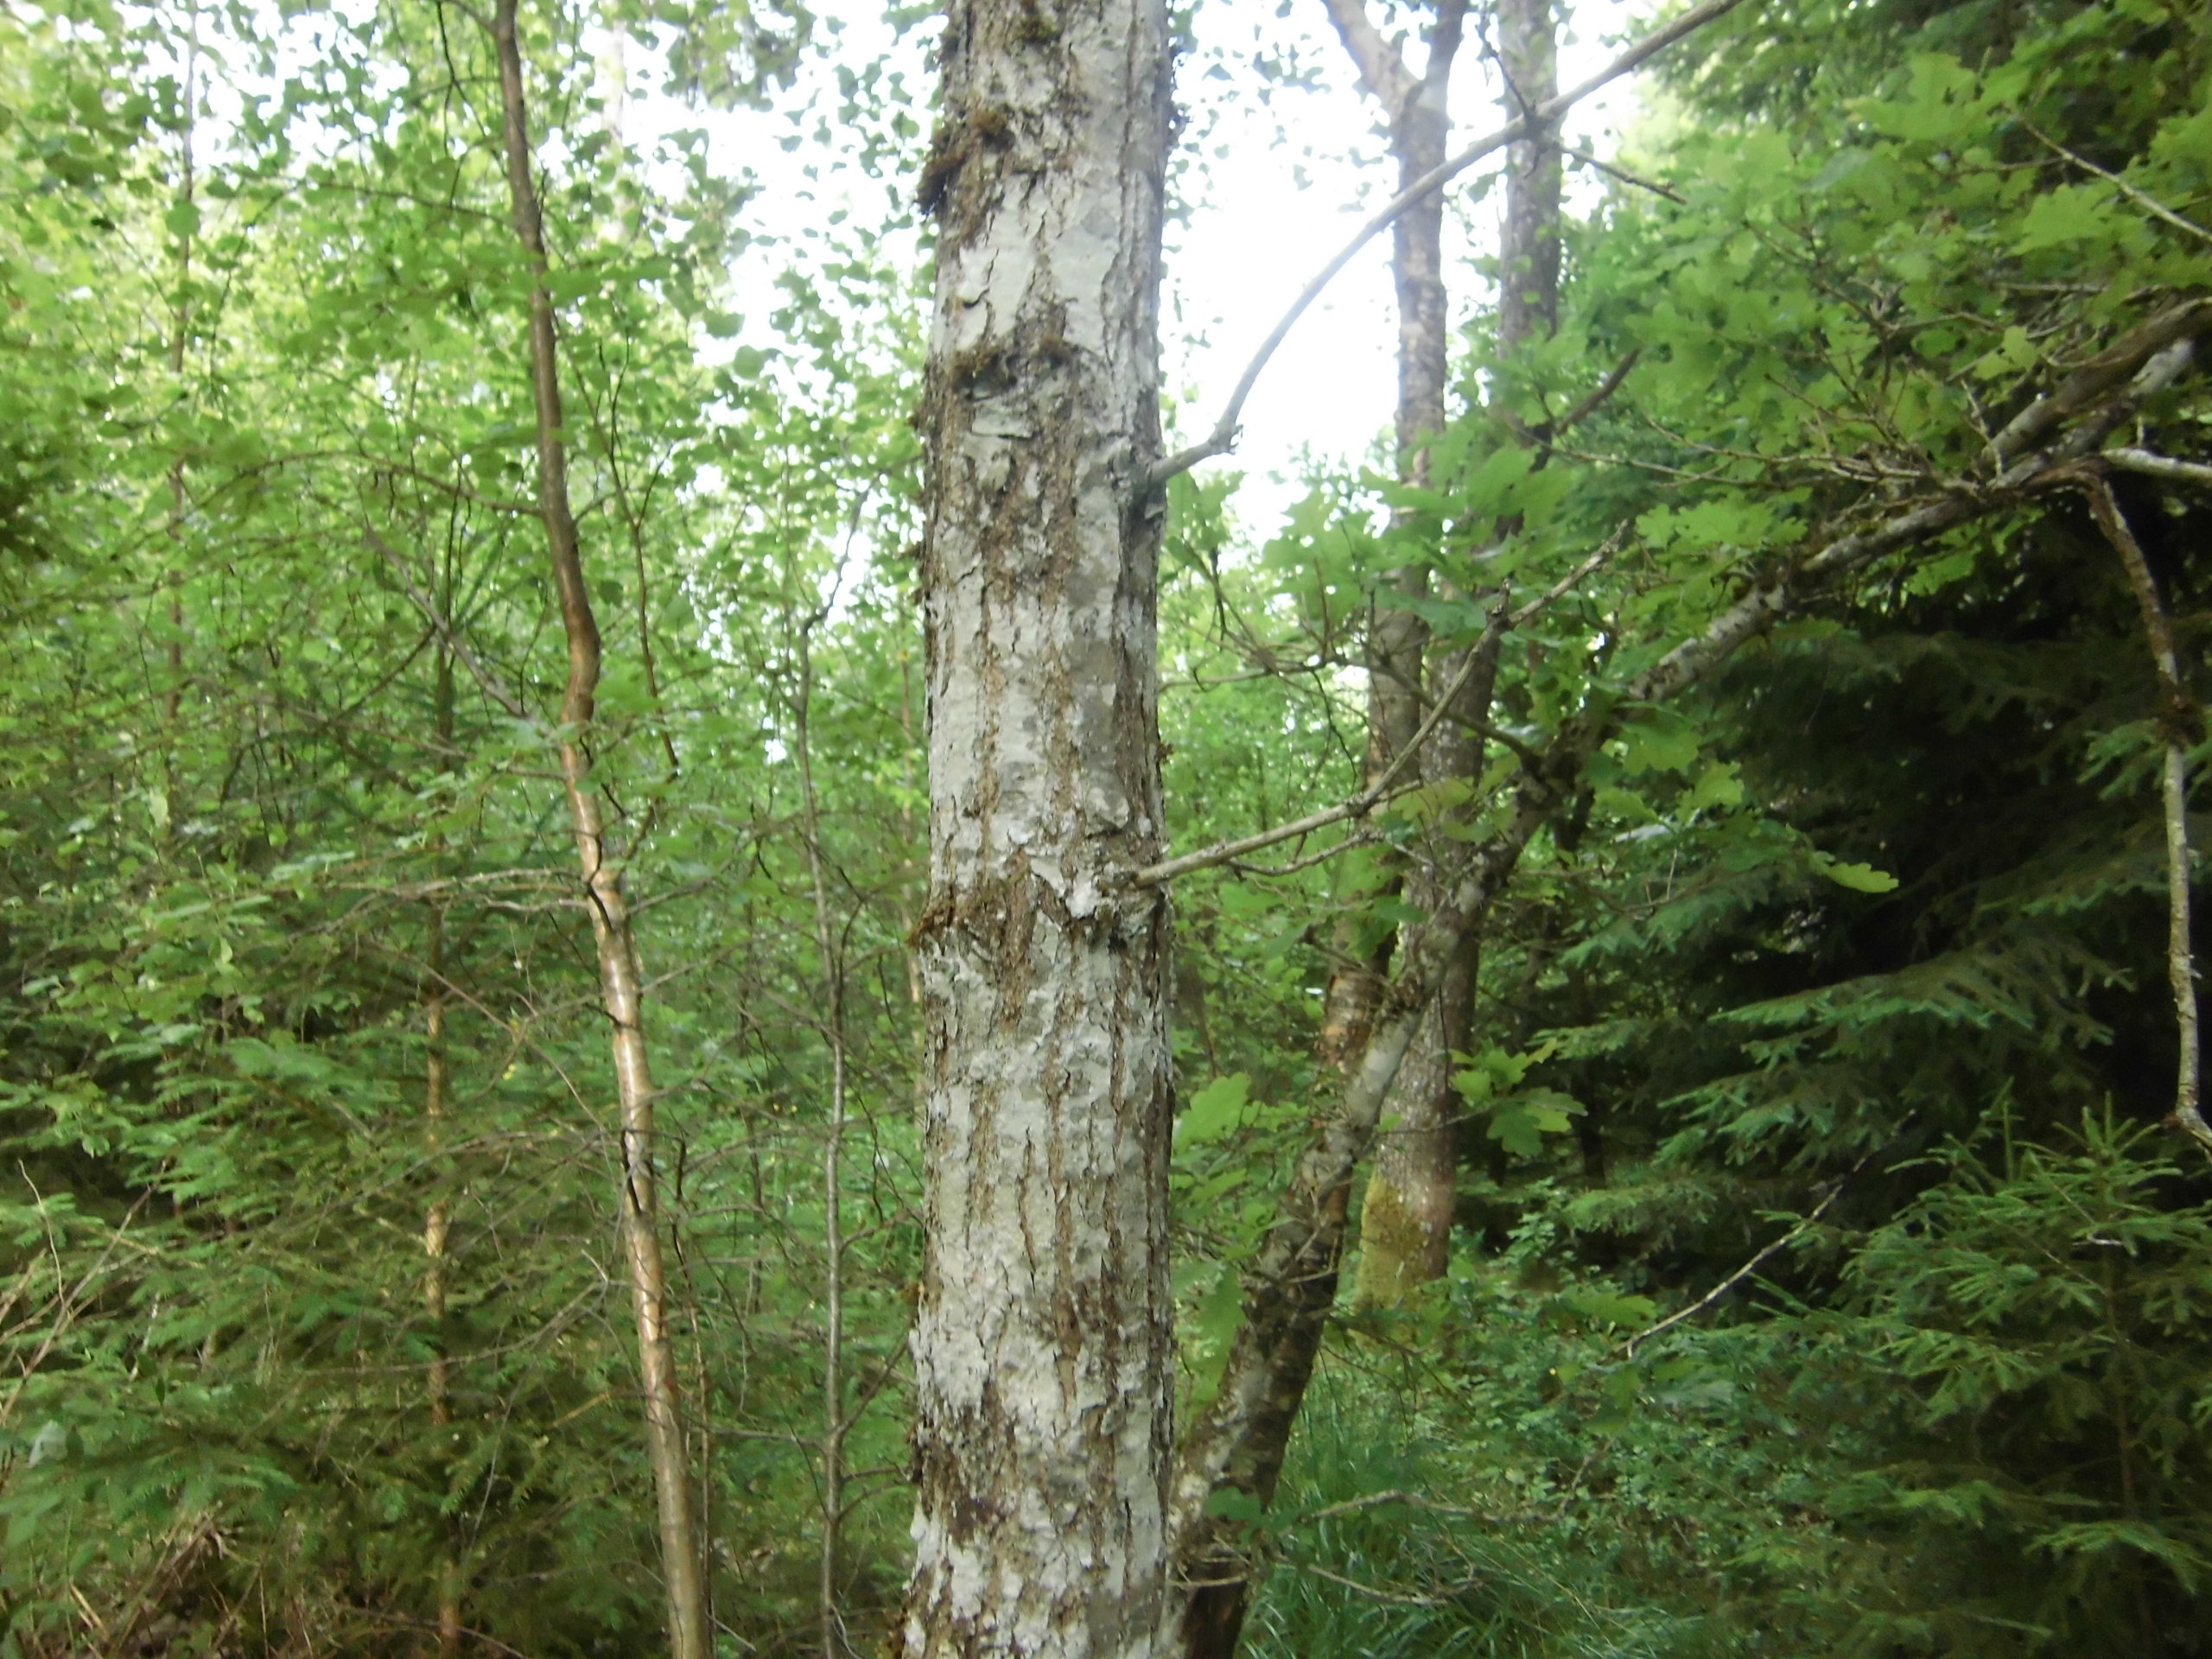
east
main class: Woodland
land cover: Spruce dominated mixed woodland
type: boreal forest
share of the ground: 50 - 75 %
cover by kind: coniferous forest trees 30 %, broadleaved forest trees 30 %, herbaceous plants 25 %, lichens and mosses 10 %, shrubs 5 %
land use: Forestry
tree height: > 5 m
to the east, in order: Spruce dominated mixed woodland; Shrubland with sparse tree cover; Broadleaved woodland; Common wheat; Dry stone walls; Broadleaved woodland; Rocks and stones; Broadleaved woodland; Spruce dominated mixed woodland
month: July
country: SE
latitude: 57.2107
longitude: 14.9139
